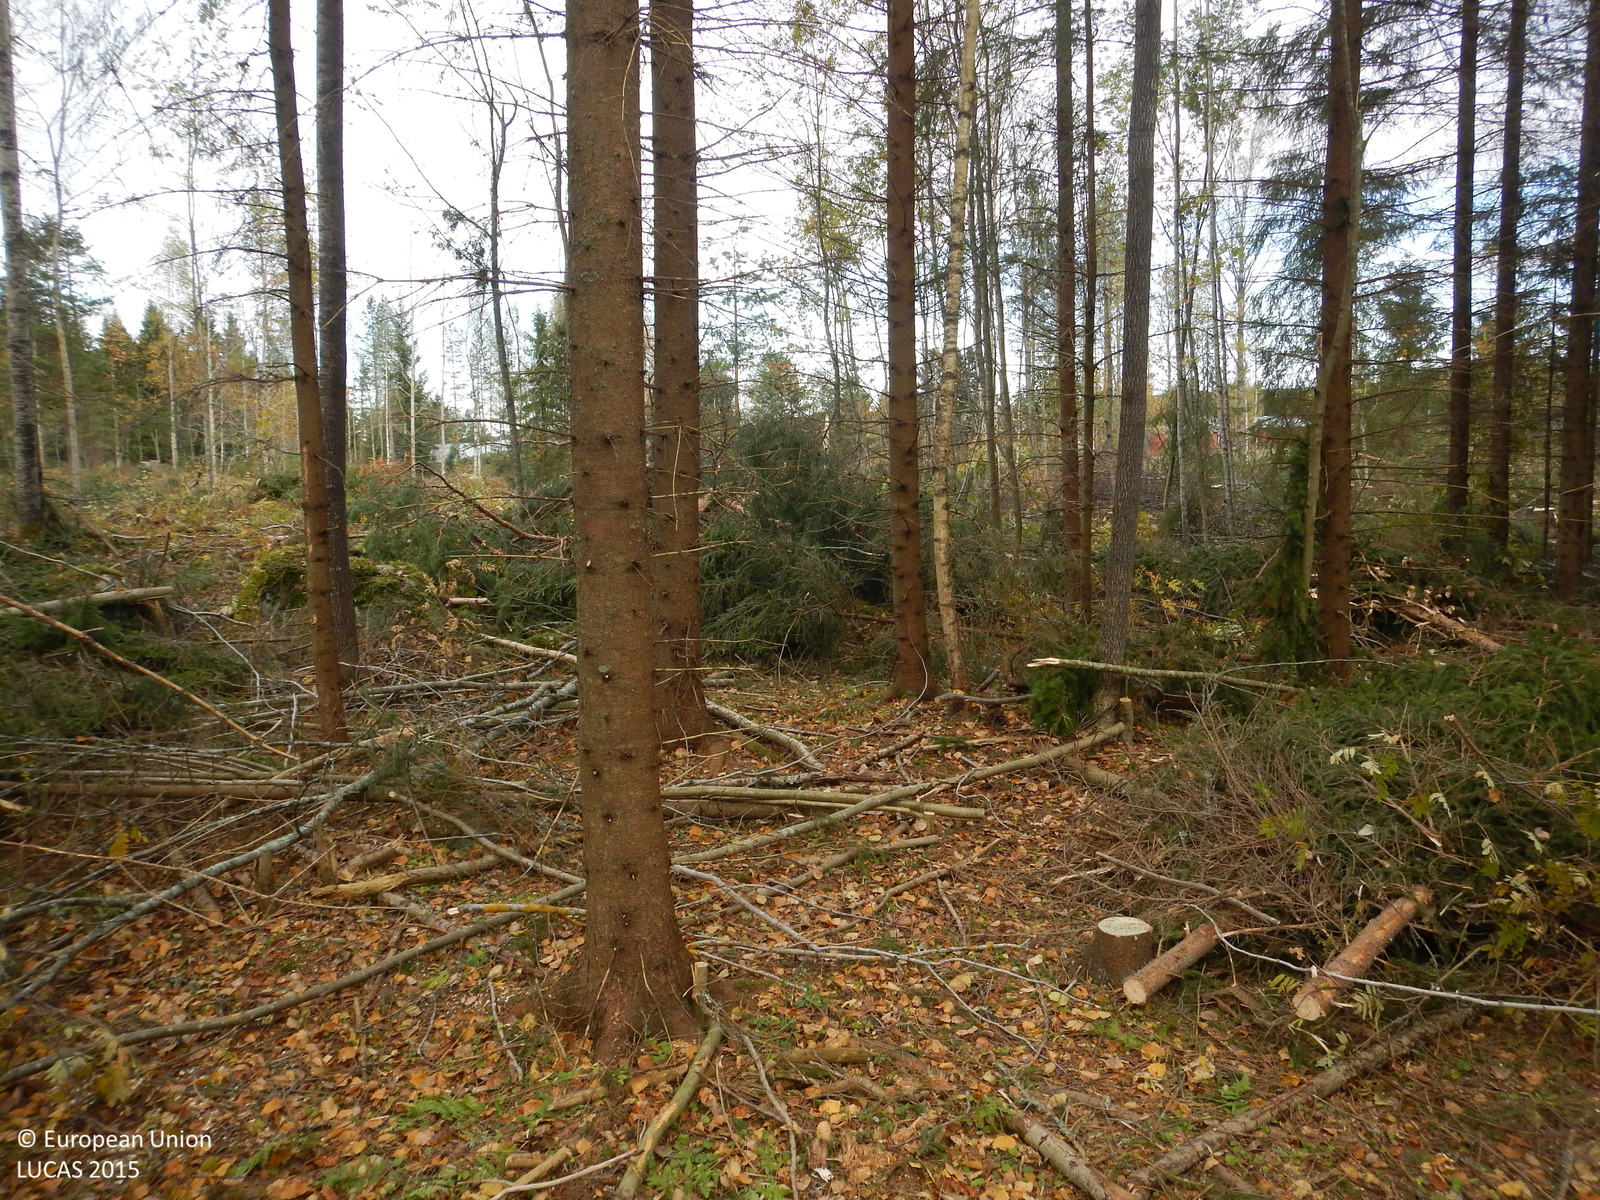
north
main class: Woodland
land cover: Spruce dominated coniferous woodland
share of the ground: > 75 %
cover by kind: coniferous forest trees 75 %, unconsolidated bare surface 20 %, broadleaved forest trees 5 %
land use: Forestry
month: October
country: FI
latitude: 61.7890
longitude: 25.9641
